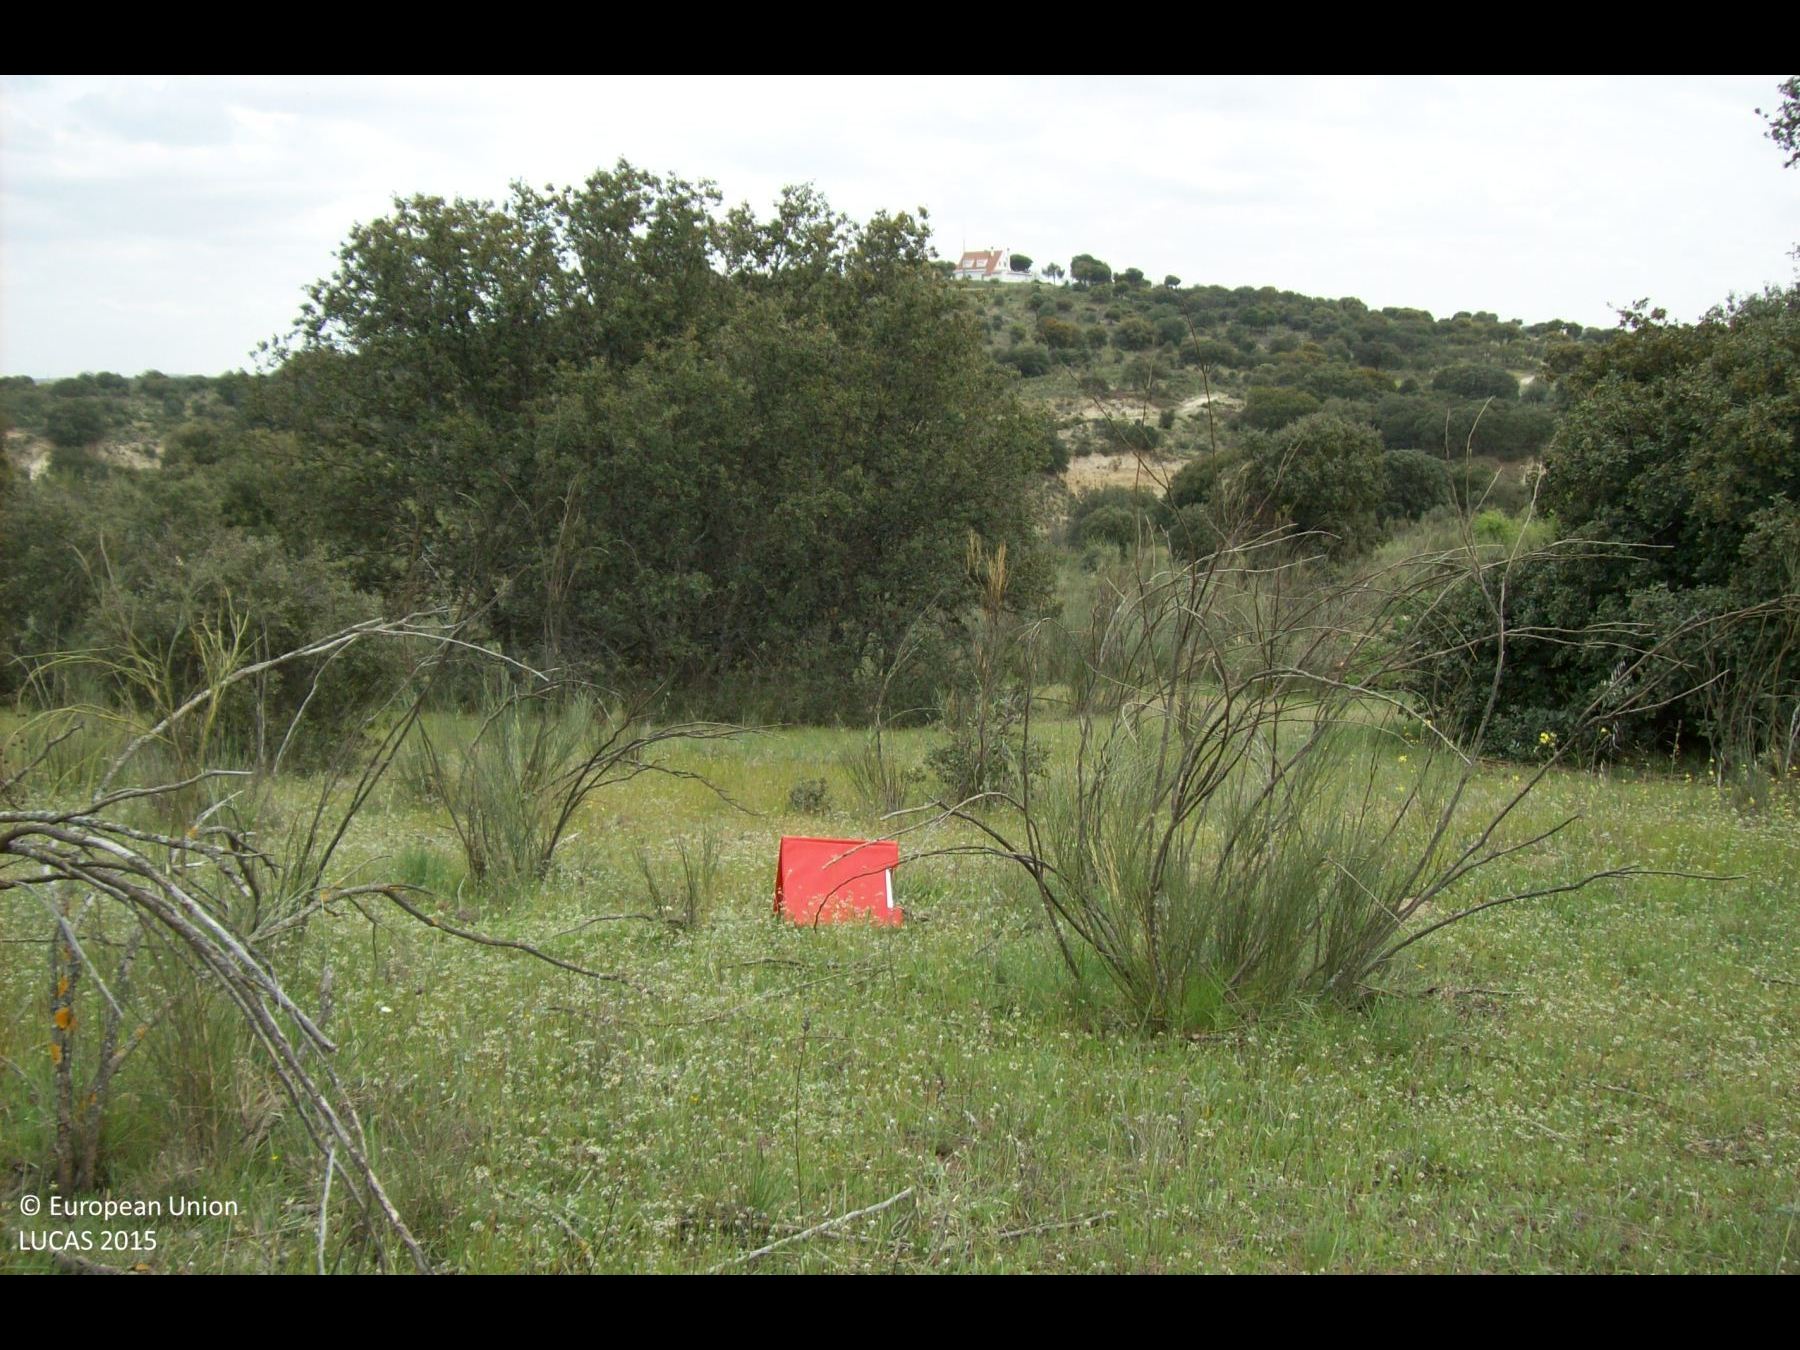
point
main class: Woodland
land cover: Broadleaved woodland
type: broadleaved evergreen forest
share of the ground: 25 - 50 %
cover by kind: herbaceous plants 65 %, broadleaved forest trees 25 %, shrubs 10 %
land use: Semi-natural and natural areas not in use
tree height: < 5 m
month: April
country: ES
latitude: 40.5106
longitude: -3.9564
